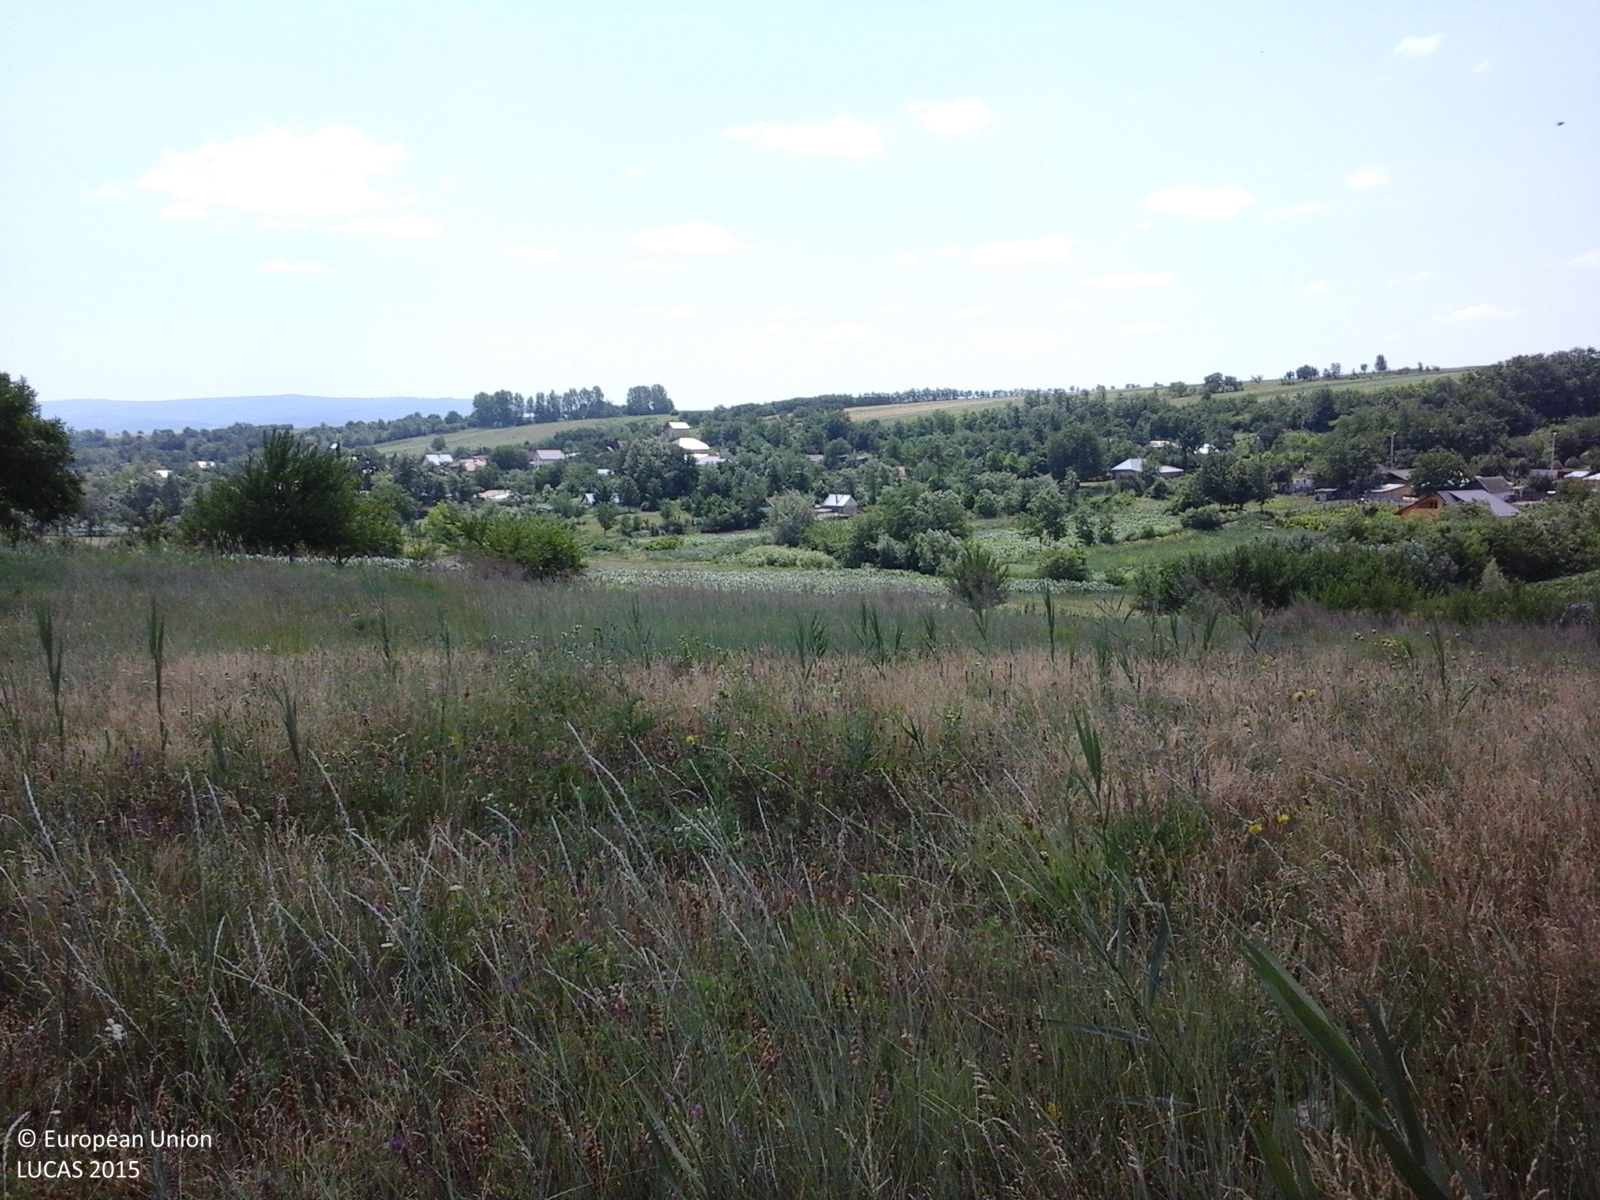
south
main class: Cropland
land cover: Vineyards
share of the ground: > 75 %
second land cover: Other bare soil
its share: > 75 %
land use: Agriculture (excluding fallow land and kitchen gardens)
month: June
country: RO
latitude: 47.2050
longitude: 27.6663
